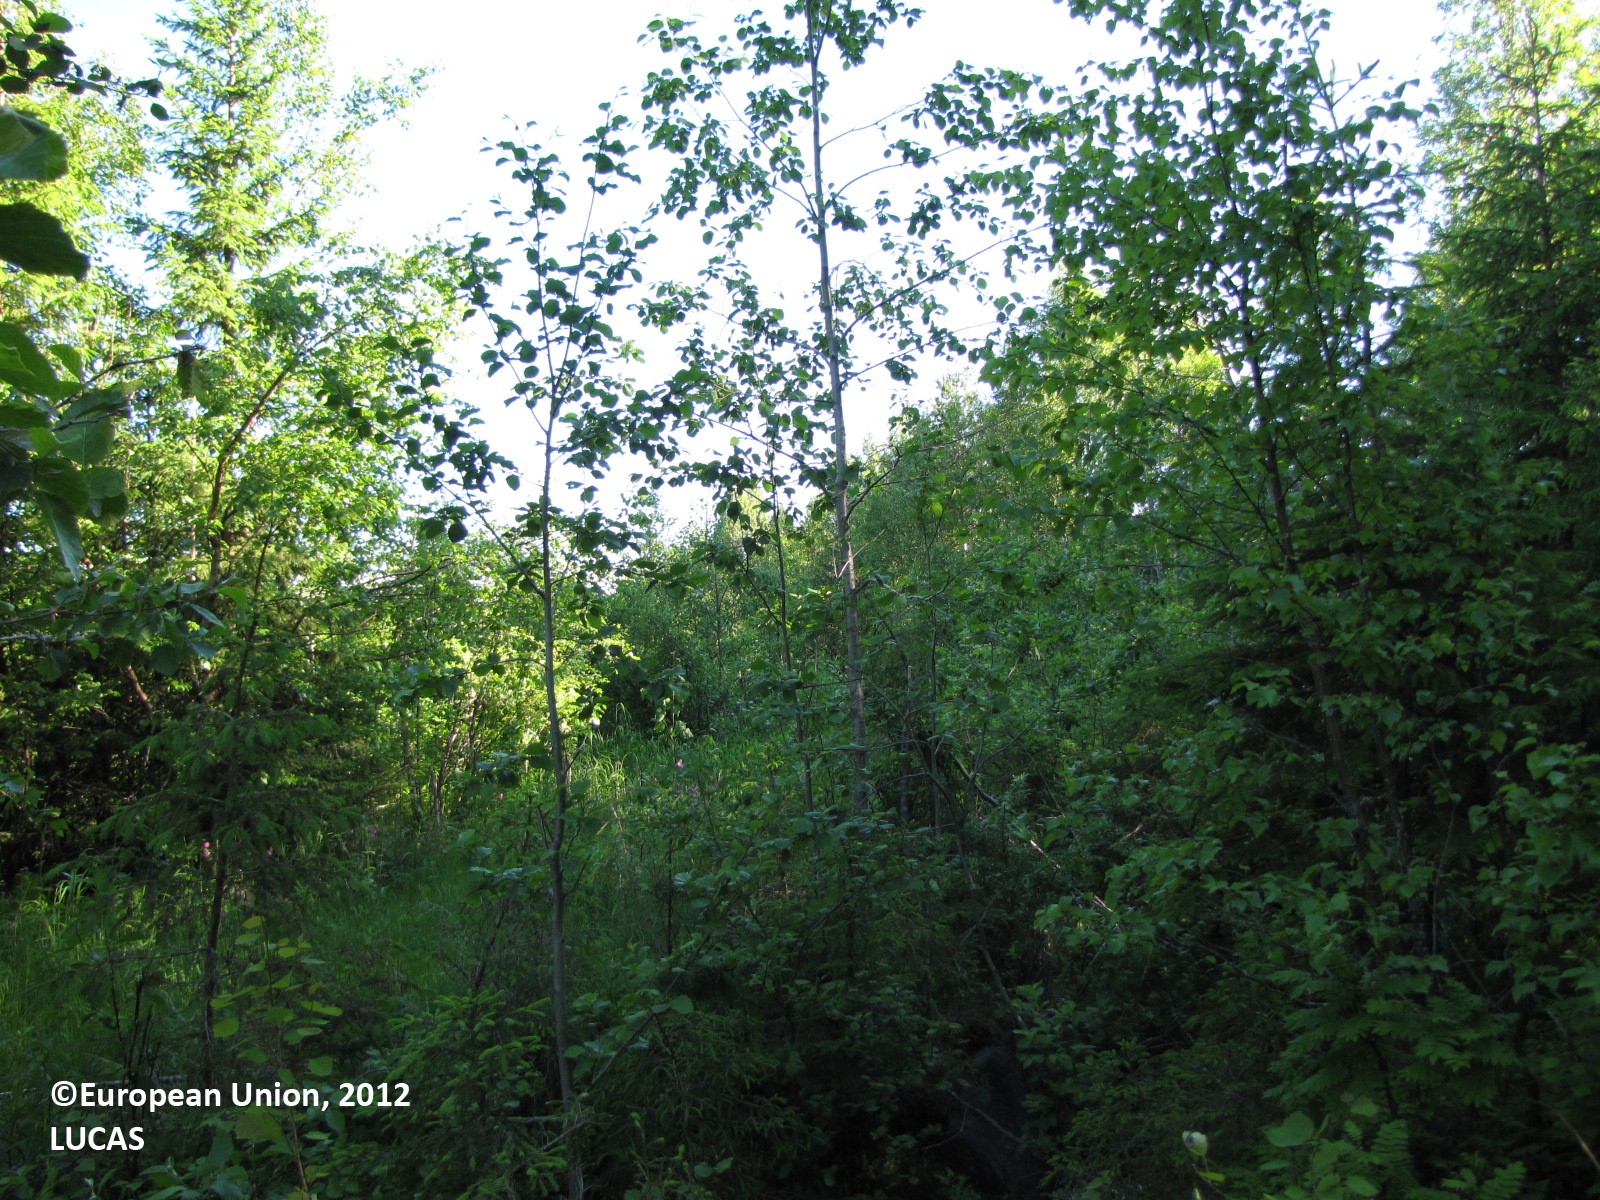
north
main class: Woodland
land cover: Spruce dominated mixed woodland
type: boreal forest
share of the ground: 25 - 50 %
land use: Forestry
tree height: > 5 m
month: July
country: FI
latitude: 66.1020
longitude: 24.1351
